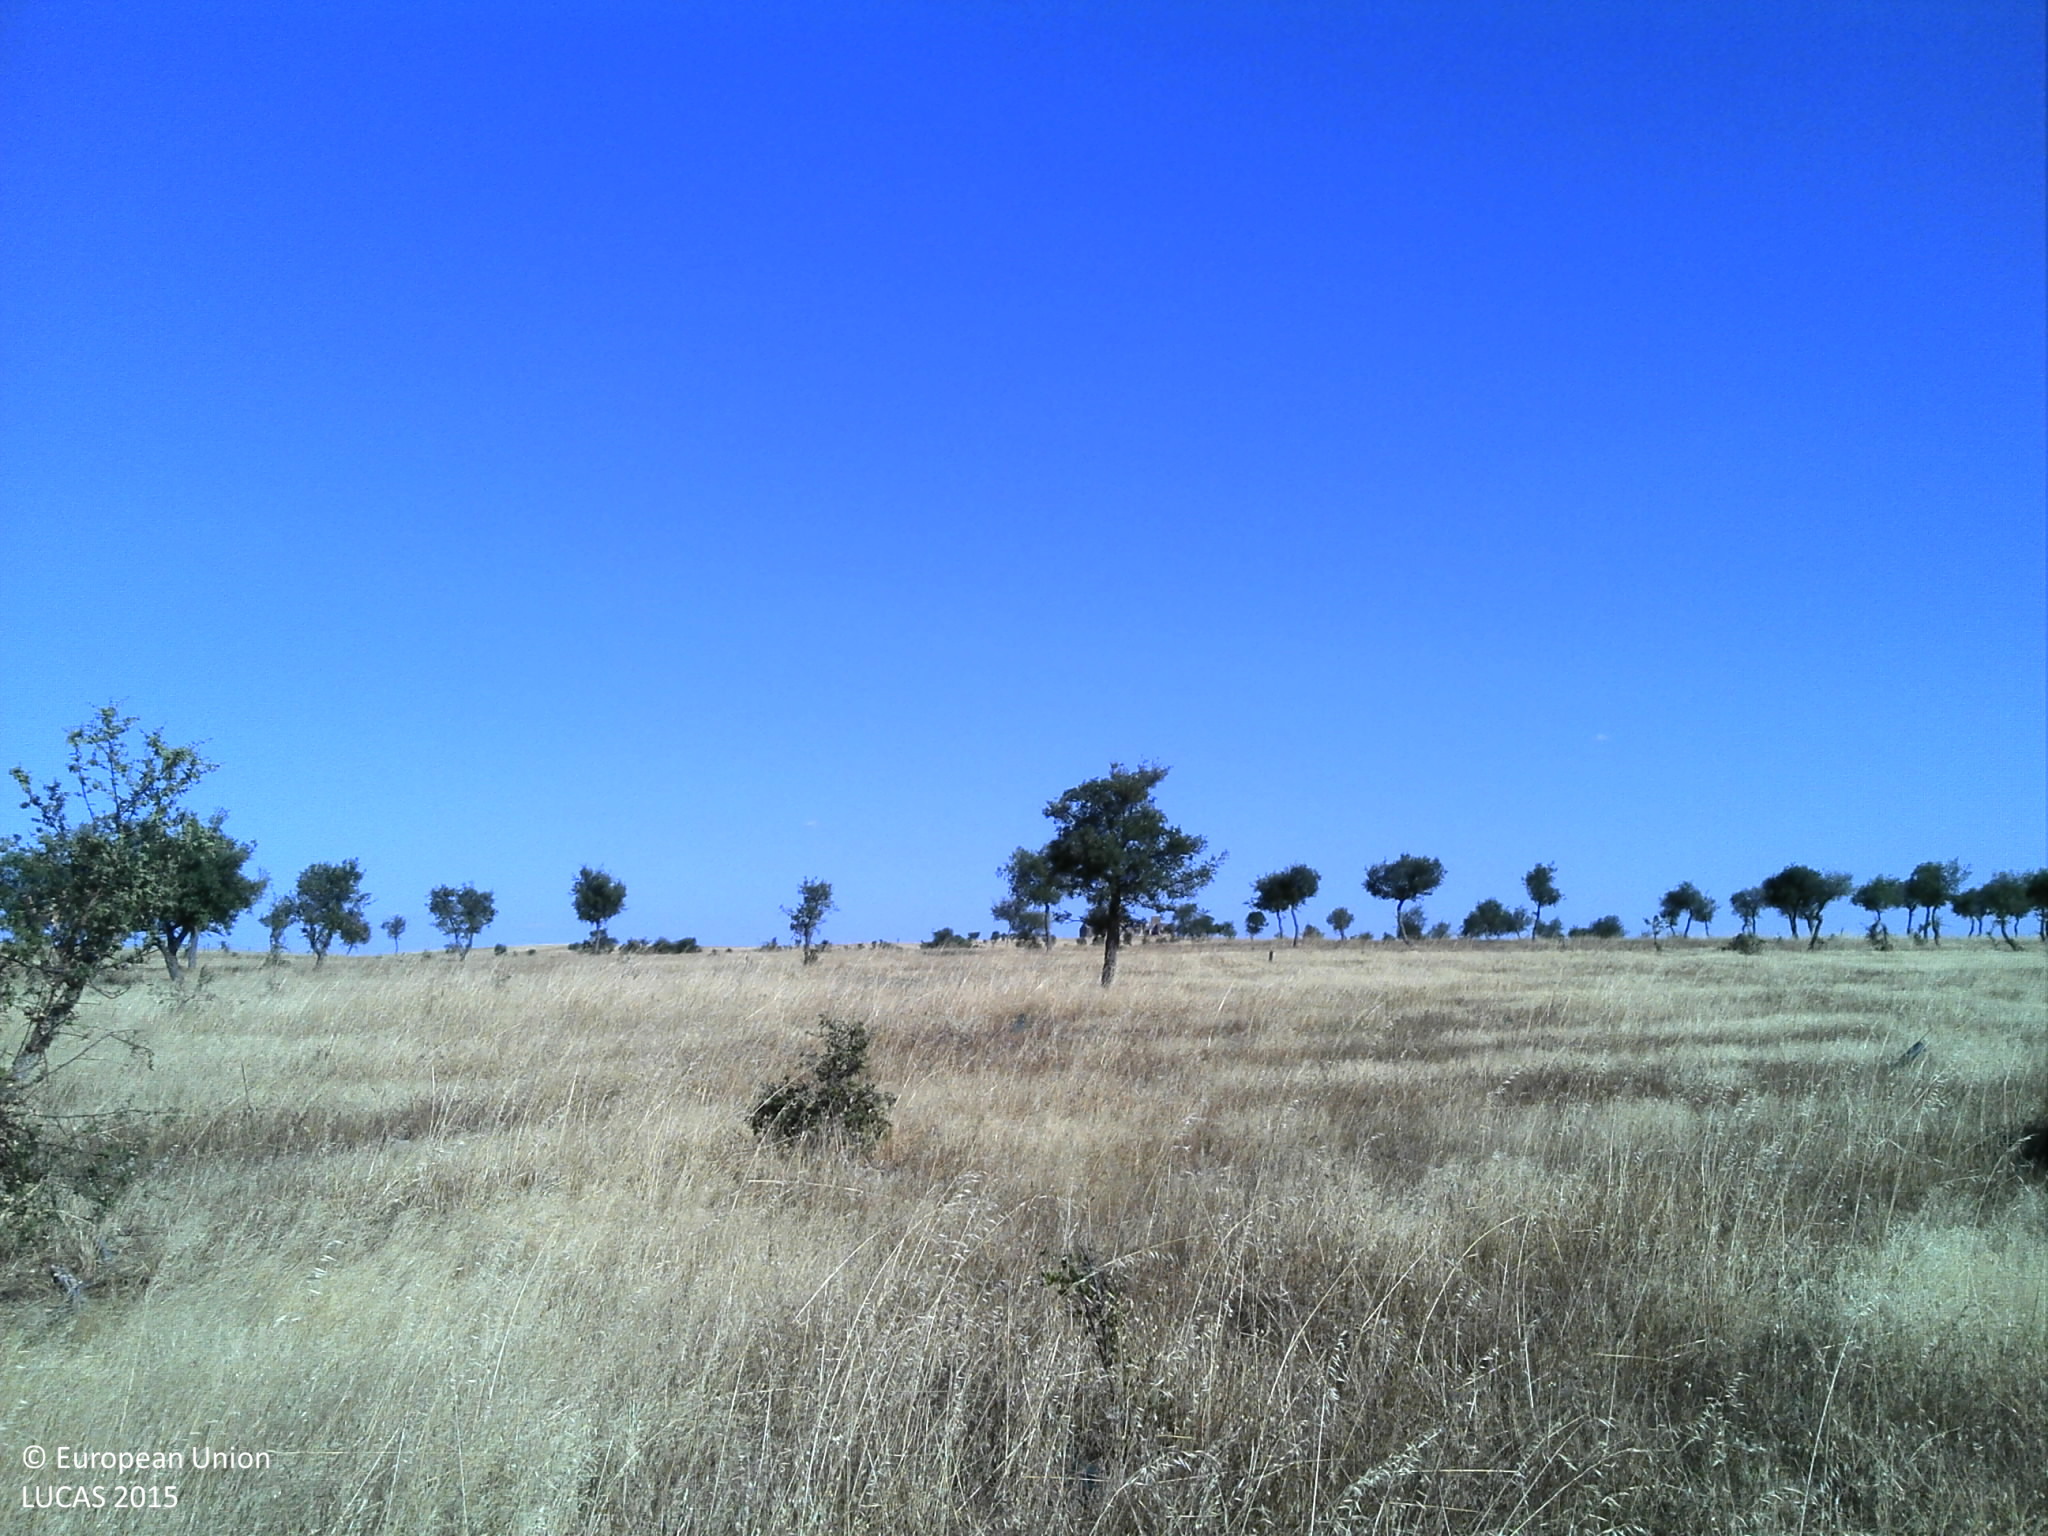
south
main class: Woodland
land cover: Broadleaved woodland
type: broadleaved evergreen forest
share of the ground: 10 - 25 %
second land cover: Grassland without tree/shrub cover
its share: 25 - 50 %
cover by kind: unconsolidated bare surface 65 %, herbaceous plants 25 %, broadleaved forest trees 10 %
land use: Forestry
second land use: Agriculture (excluding fallow land and kitchen gardens)
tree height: < 5 m
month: June
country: PT
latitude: 38.4624
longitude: -7.9746
